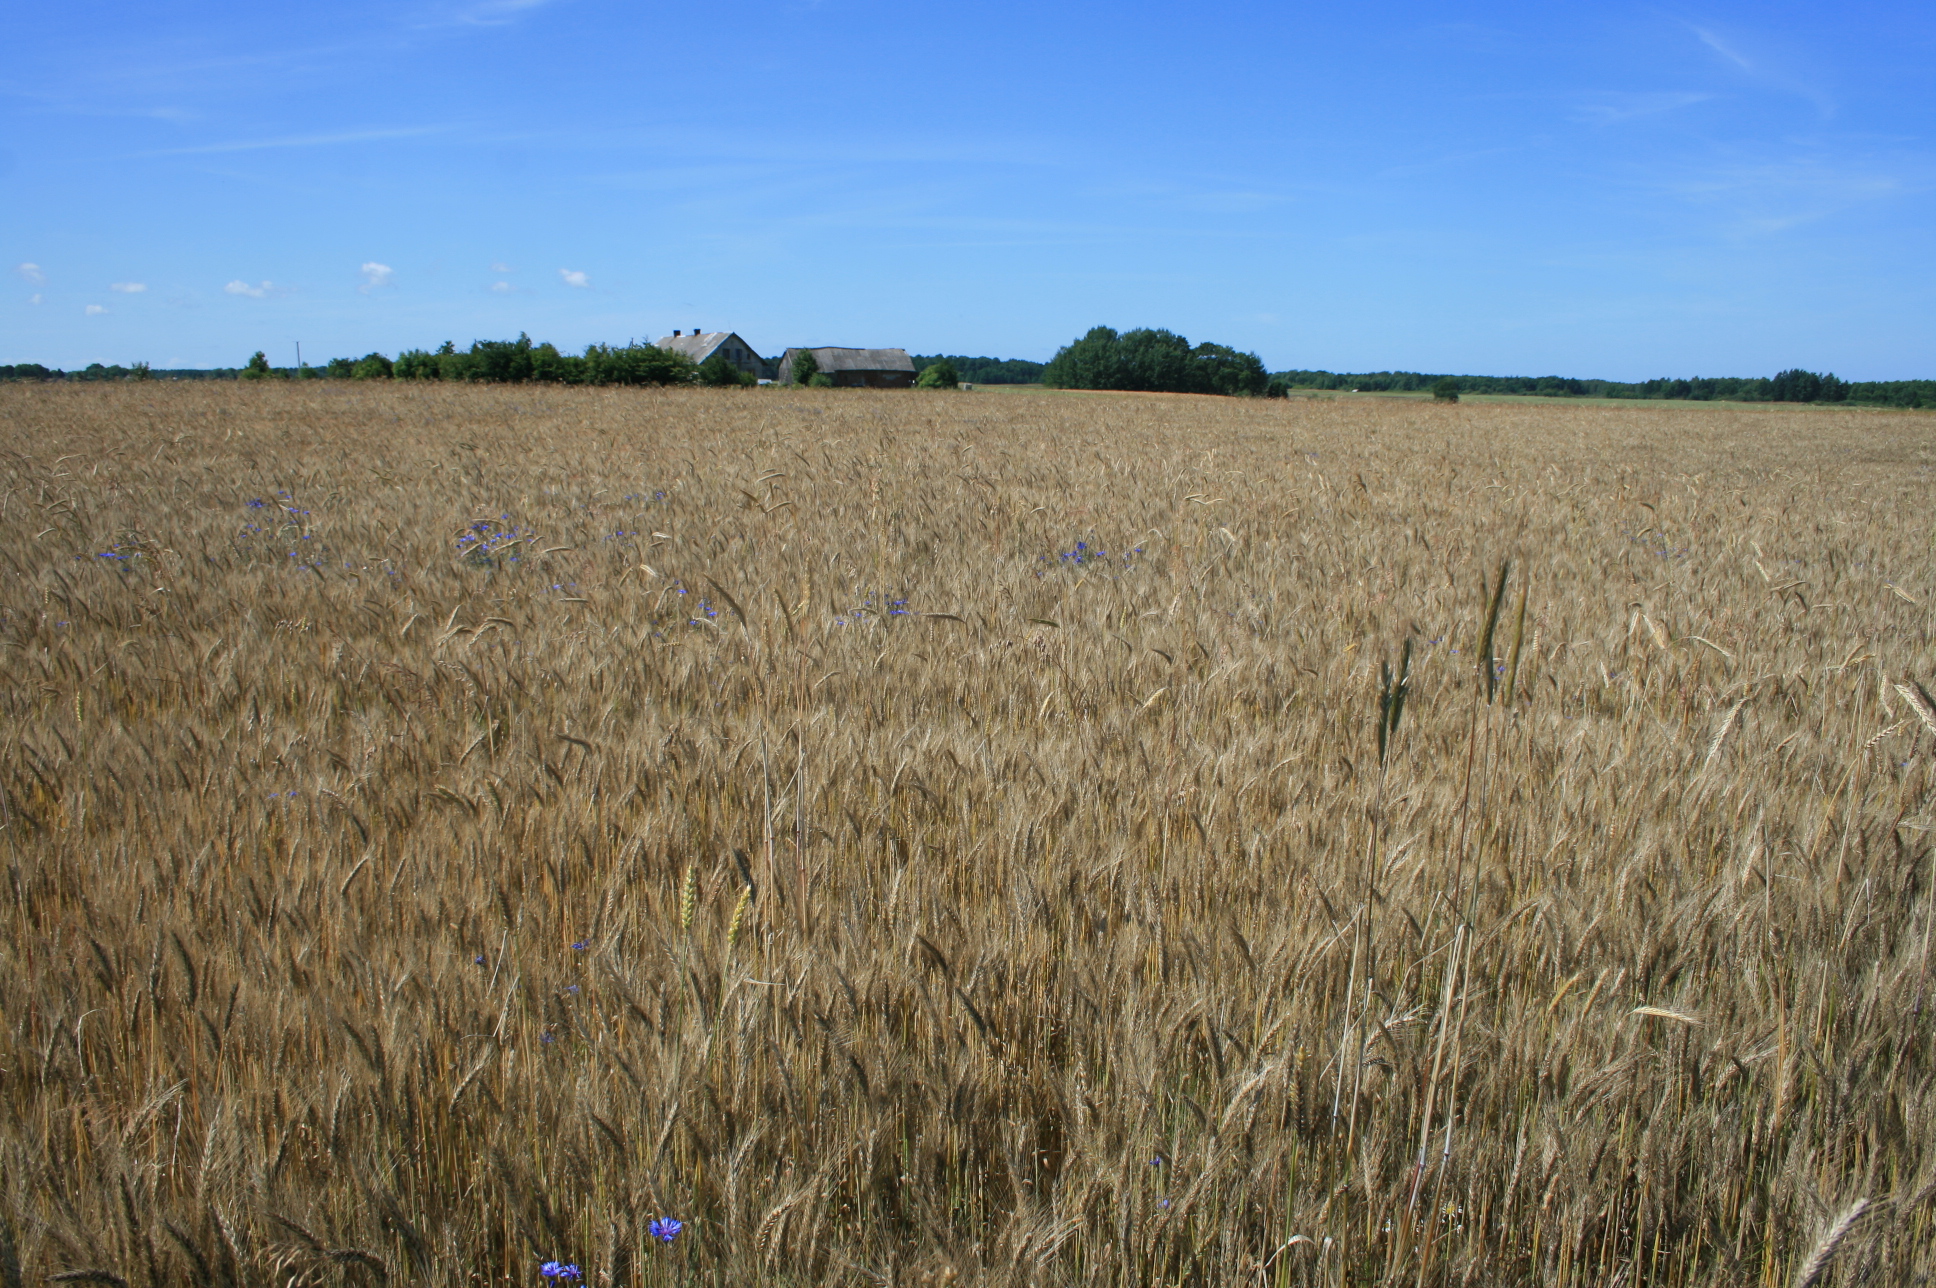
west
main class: Cropland
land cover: Triticale
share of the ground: > 75 %
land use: Agriculture (excluding fallow land and kitchen gardens)
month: July
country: LT
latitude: 55.4669
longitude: 21.3213
